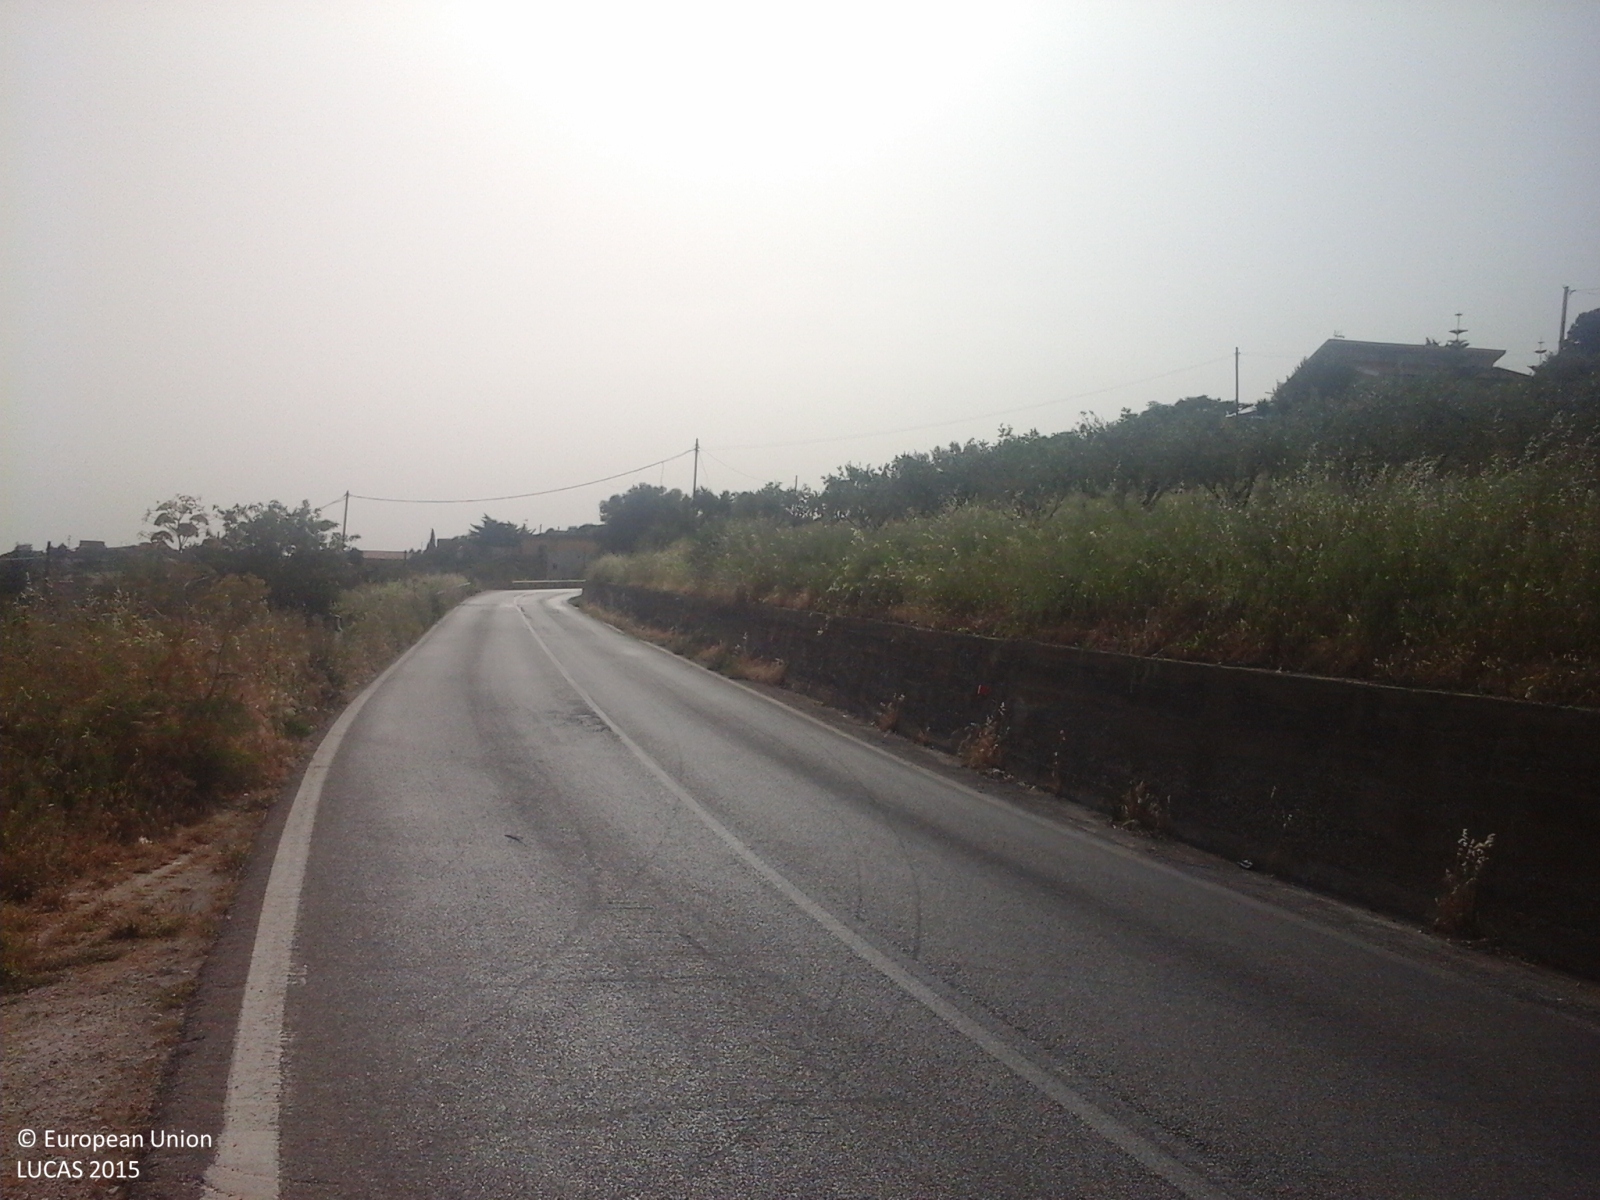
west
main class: Cropland
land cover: Olive groves
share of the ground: > 75 %
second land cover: Spontaneously vegetated surfaces
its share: > 75 %
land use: Agriculture (excluding fallow land and kitchen gardens)
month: May
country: IT
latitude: 37.4660
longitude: 13.9388
